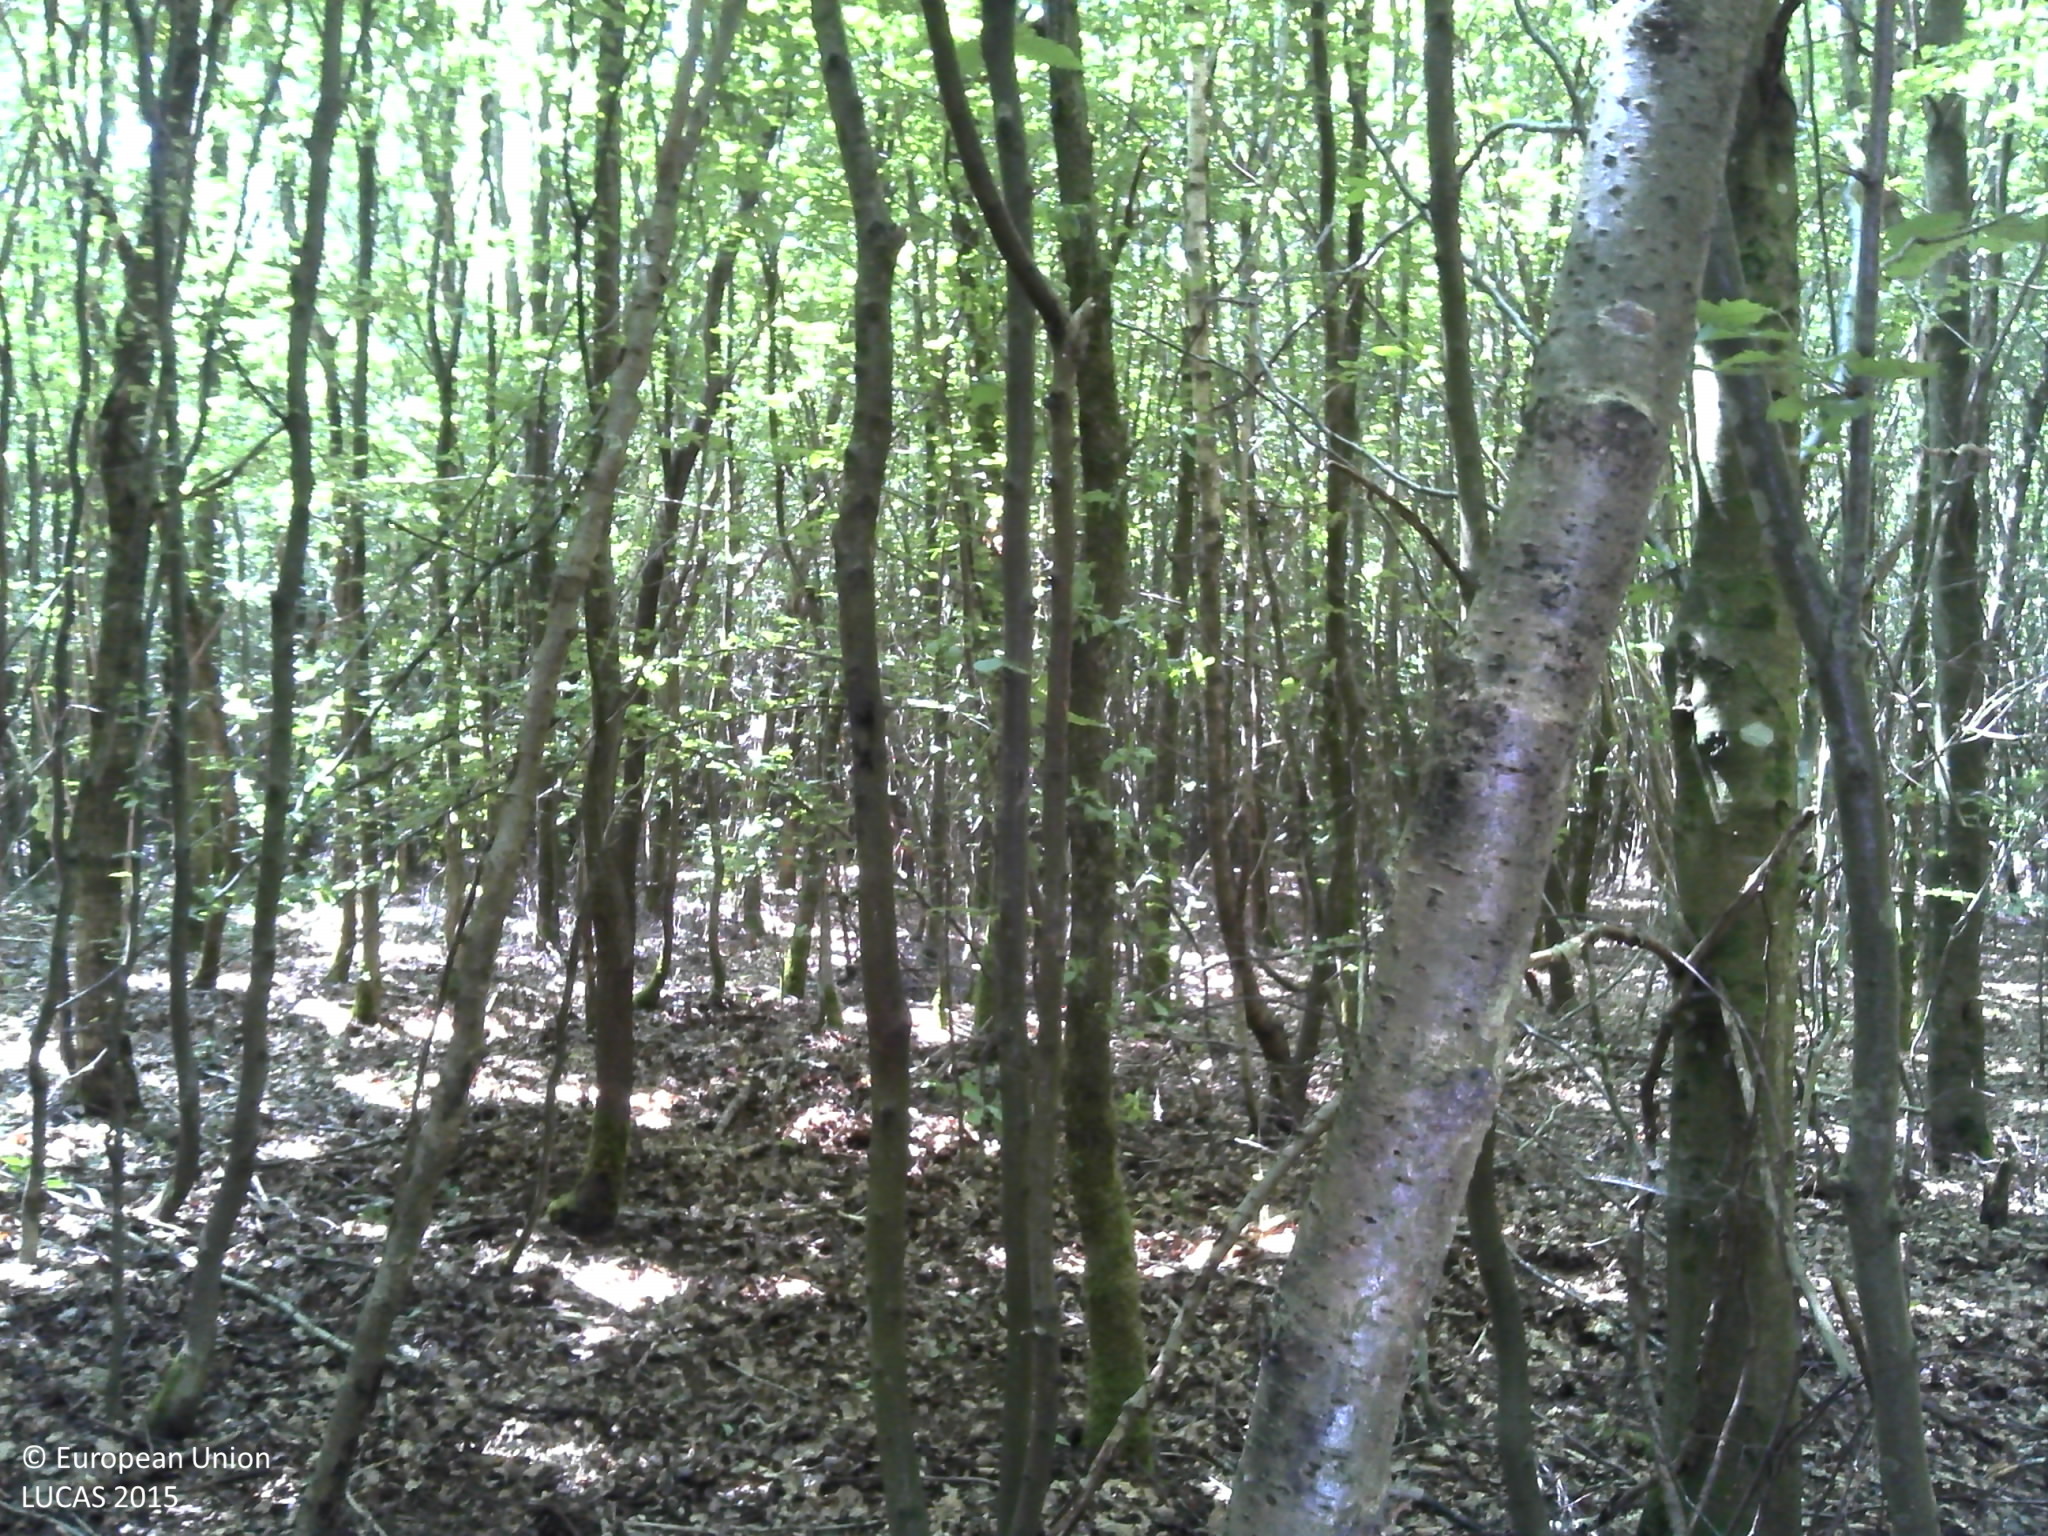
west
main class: Woodland
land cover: Broadleaved woodland
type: beech forest
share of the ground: > 75 %
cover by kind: broadleaved forest trees 70 %, consolidated bare surface 20 %, herbaceous plants 5 %, lichens and mosses 5 %
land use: Forestry
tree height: > 5 m
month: June
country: FR
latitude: 49.6708
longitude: 5.2452
